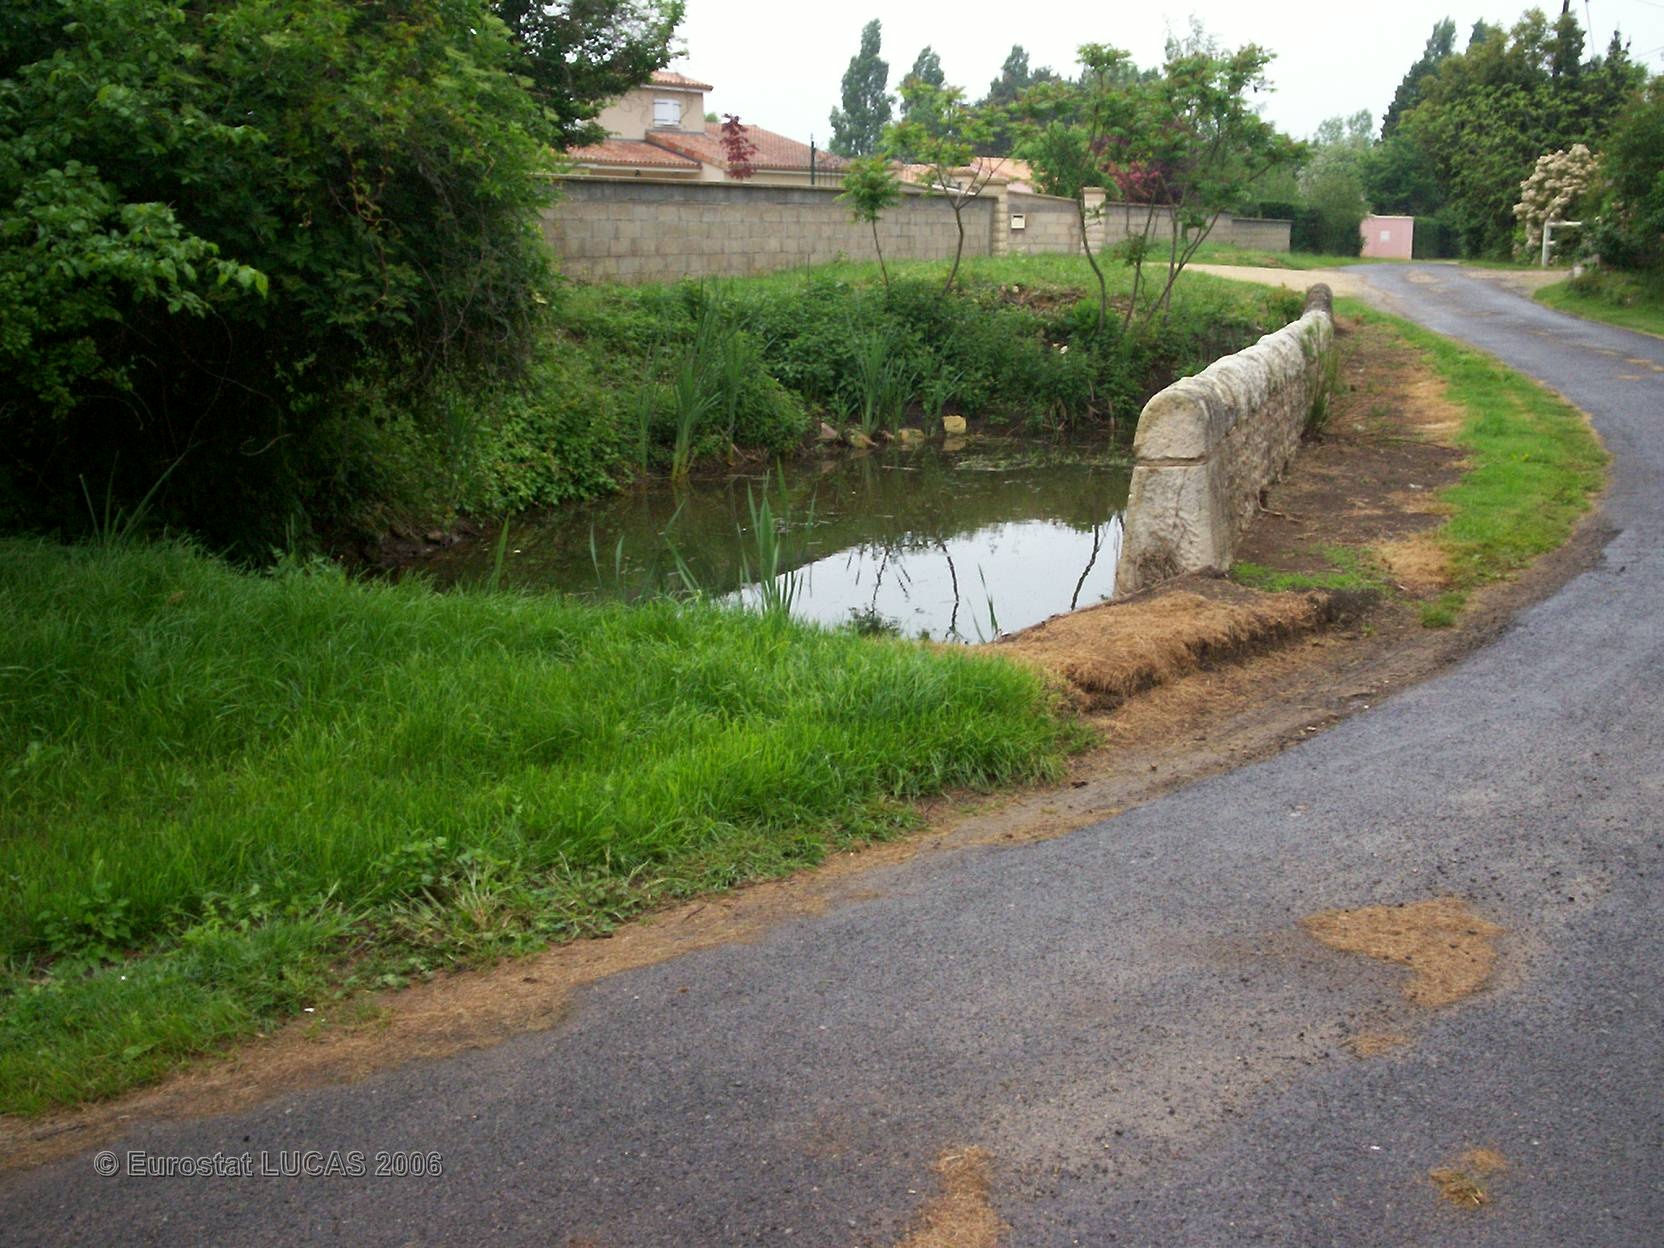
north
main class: Grassland
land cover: Grassland without tree/shrub cover
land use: Residential
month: May
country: FR
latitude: 46.5239
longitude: 0.4791
